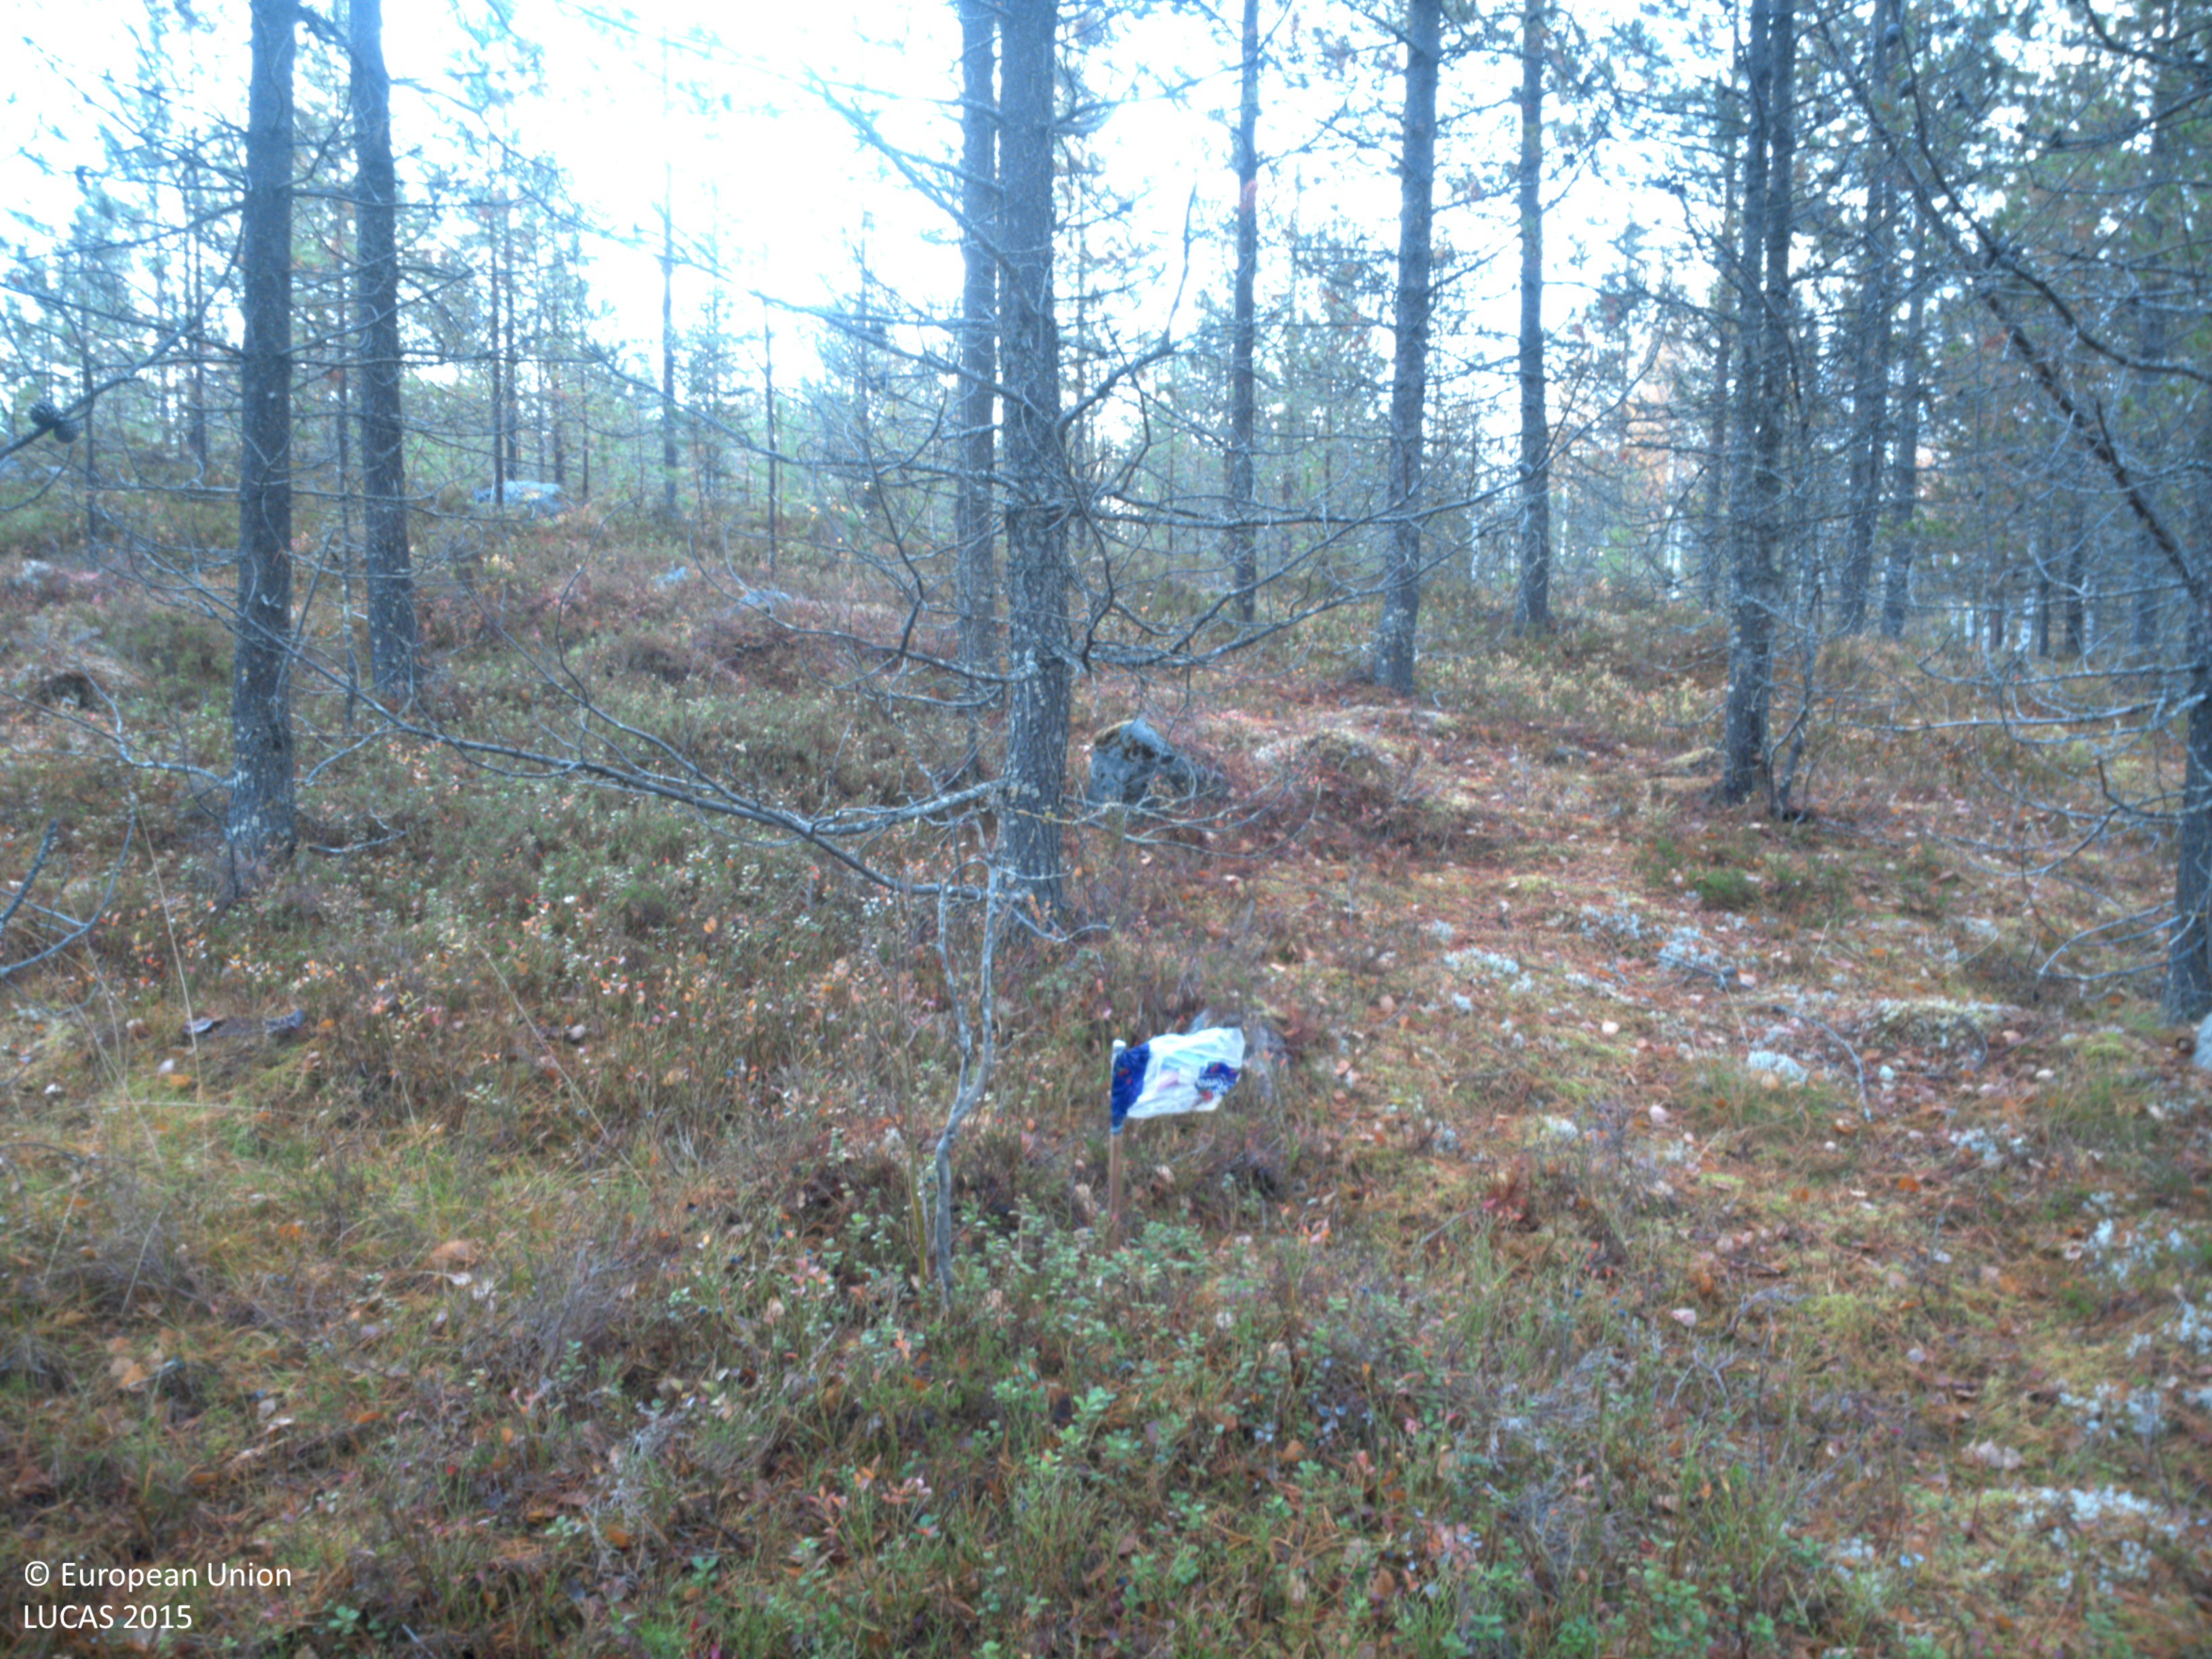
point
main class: Woodland
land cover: Pine dominated coniferous woodland
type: exotic forest
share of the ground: > 75 %
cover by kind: coniferous forest trees 75 %, shrubs 10 %, lichens and mosses 10 %, herbaceous plants 5 %
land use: Forestry
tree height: > 5 m
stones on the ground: 25 - 50 %
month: October
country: SE
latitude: 63.8268
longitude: 18.1211
